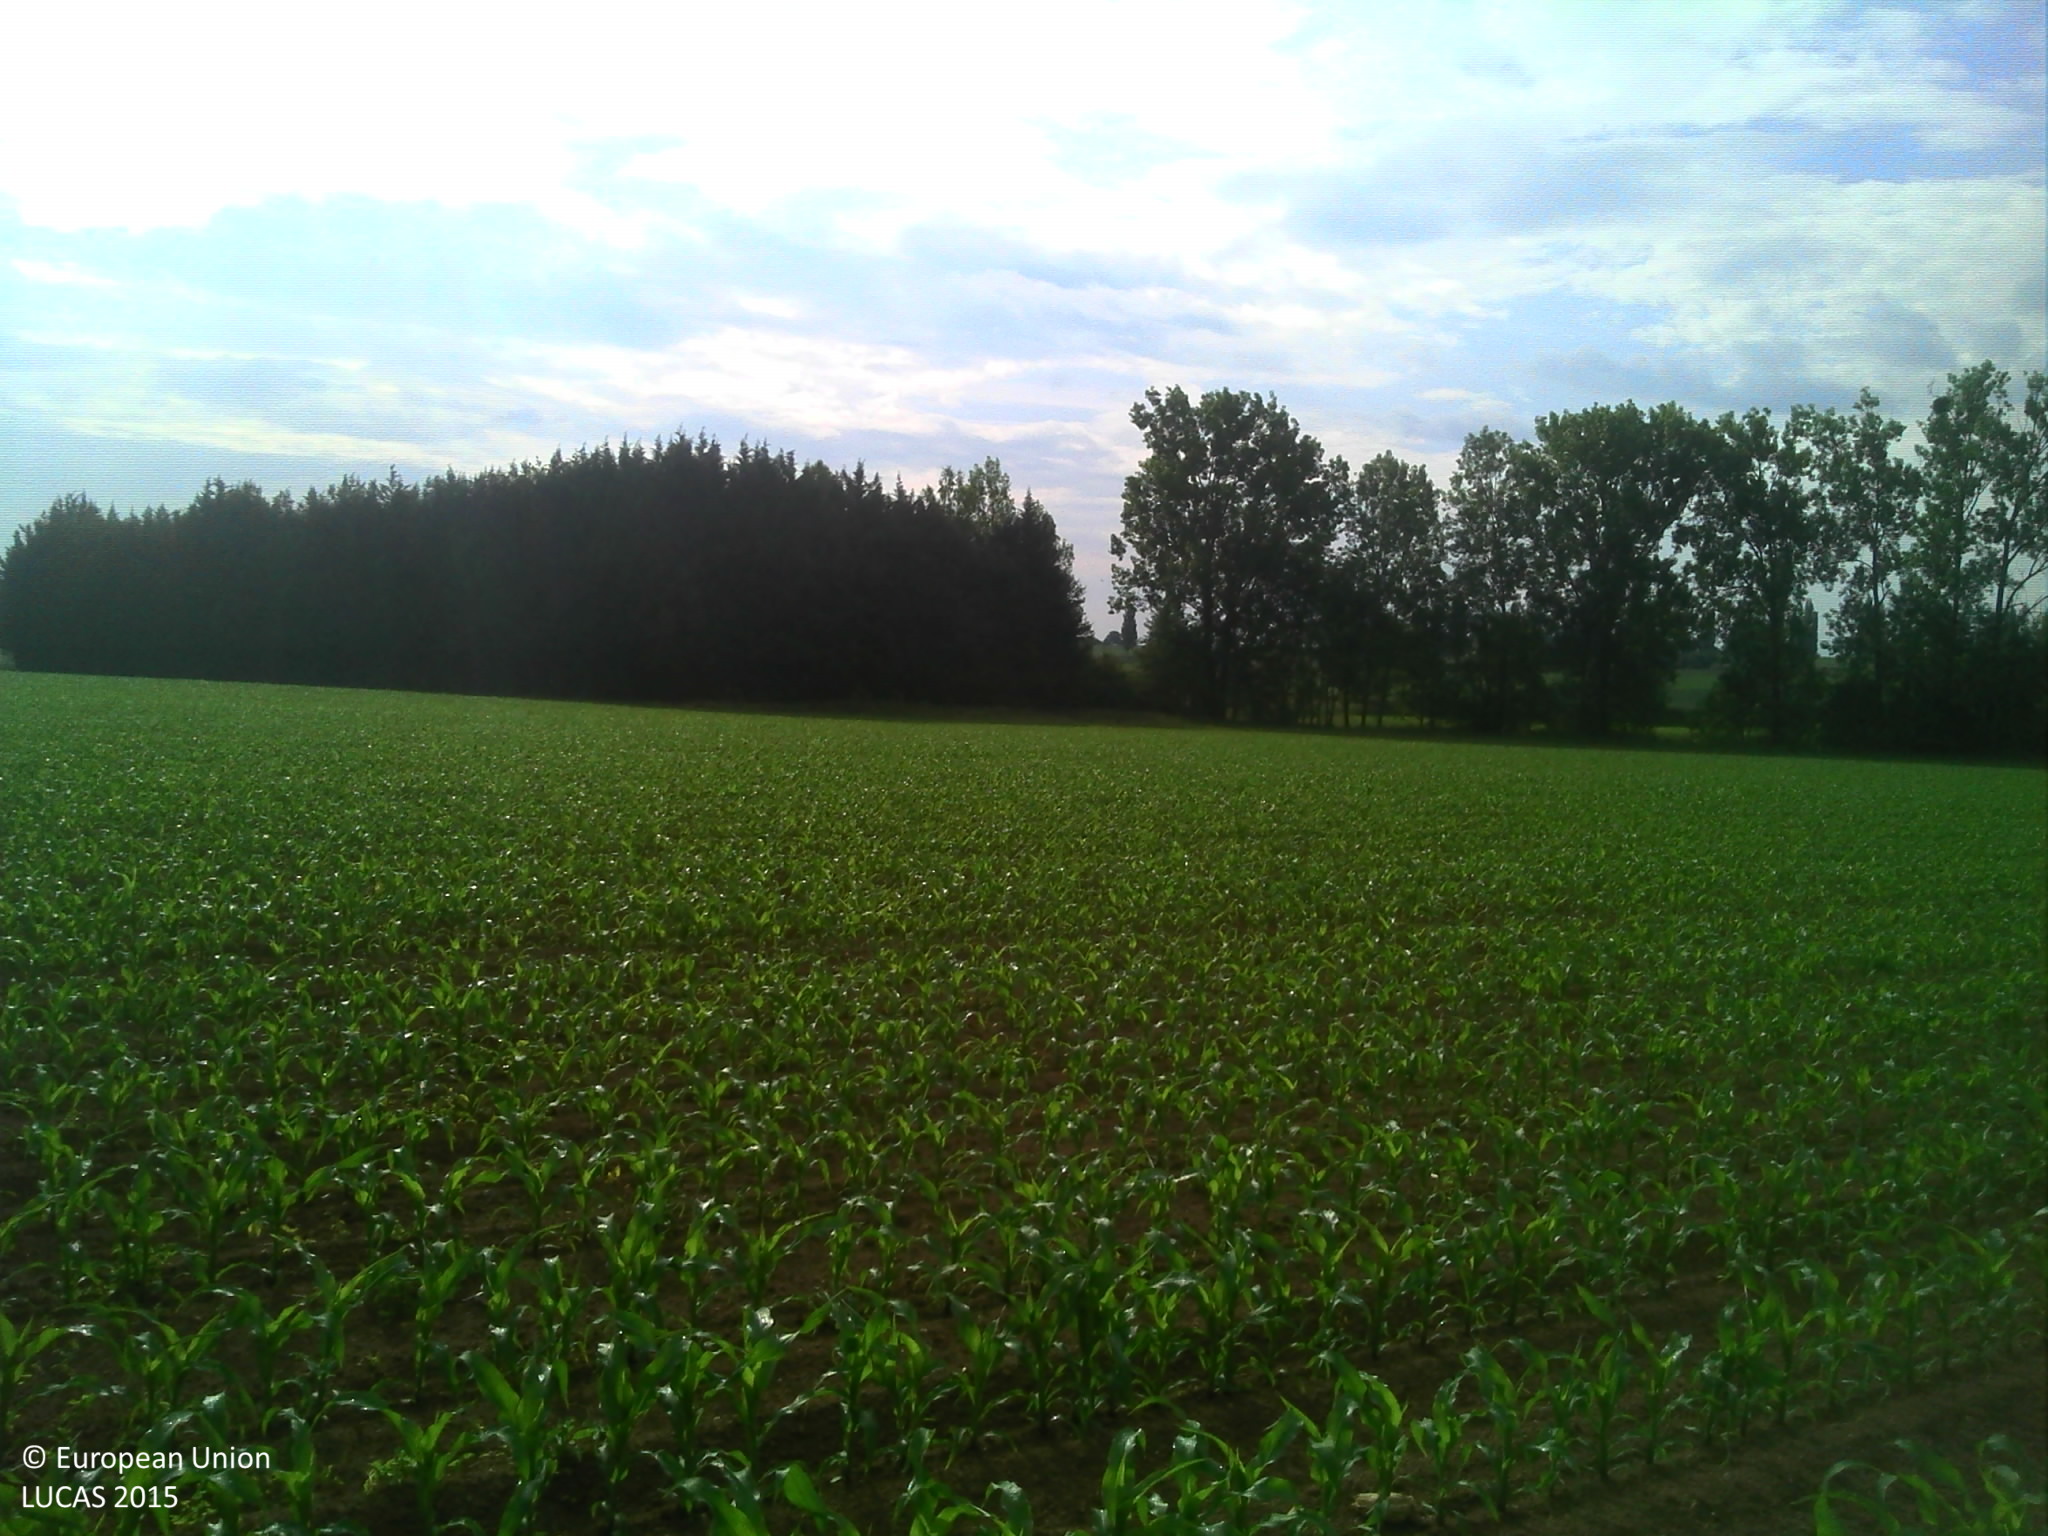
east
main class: Cropland
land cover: Maize
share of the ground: 10 - 25 %
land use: Agriculture (excluding fallow land and kitchen gardens)
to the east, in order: Maize; Tracks; Lines of trees; Grassland with sparse tree/shrub cover; Lines of trees; Tracks; Rivers and streams; Grassland with sparse tree/shrub cover; Maize
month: May
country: FR
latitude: 48.6103
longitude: 7.5459
